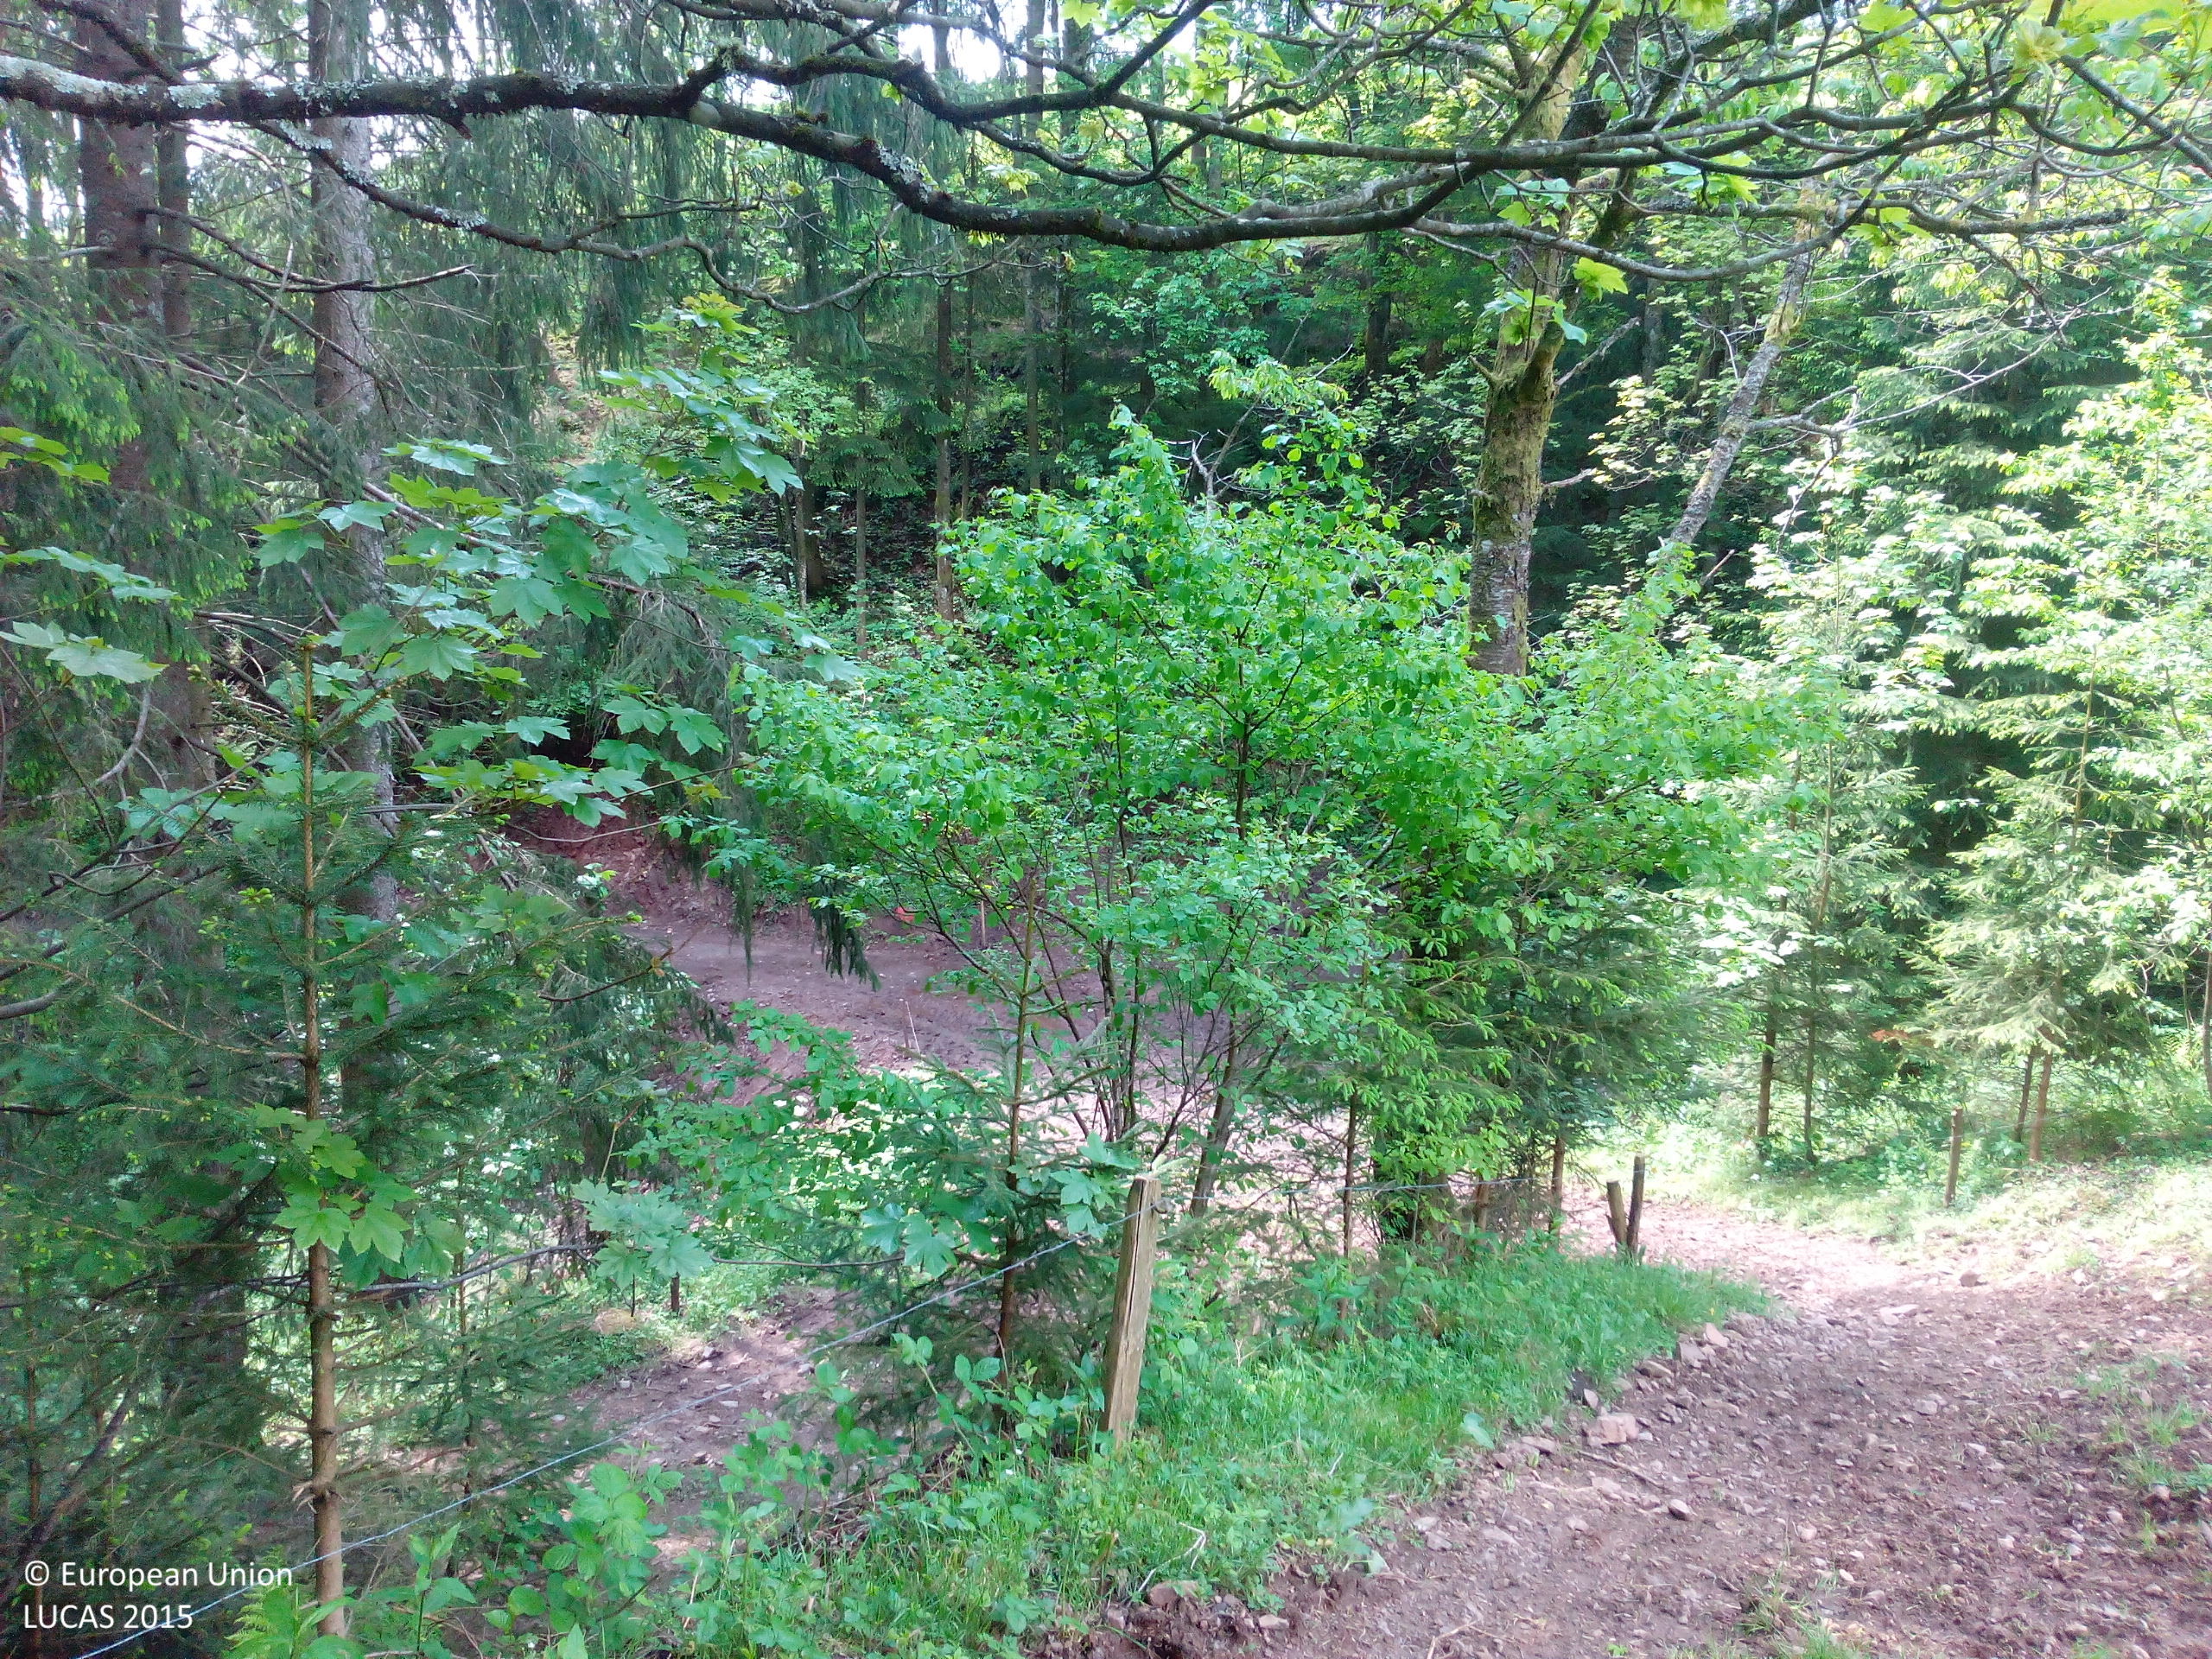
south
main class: Grassland
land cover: Grassland without tree/shrub cover
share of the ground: 25 - 50 %
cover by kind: unconsolidated bare surface 55 %, herbaceous plants 45 %
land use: Agriculture (excluding fallow land and kitchen gardens)
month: May
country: DE
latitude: 48.0094
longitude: 8.1110
